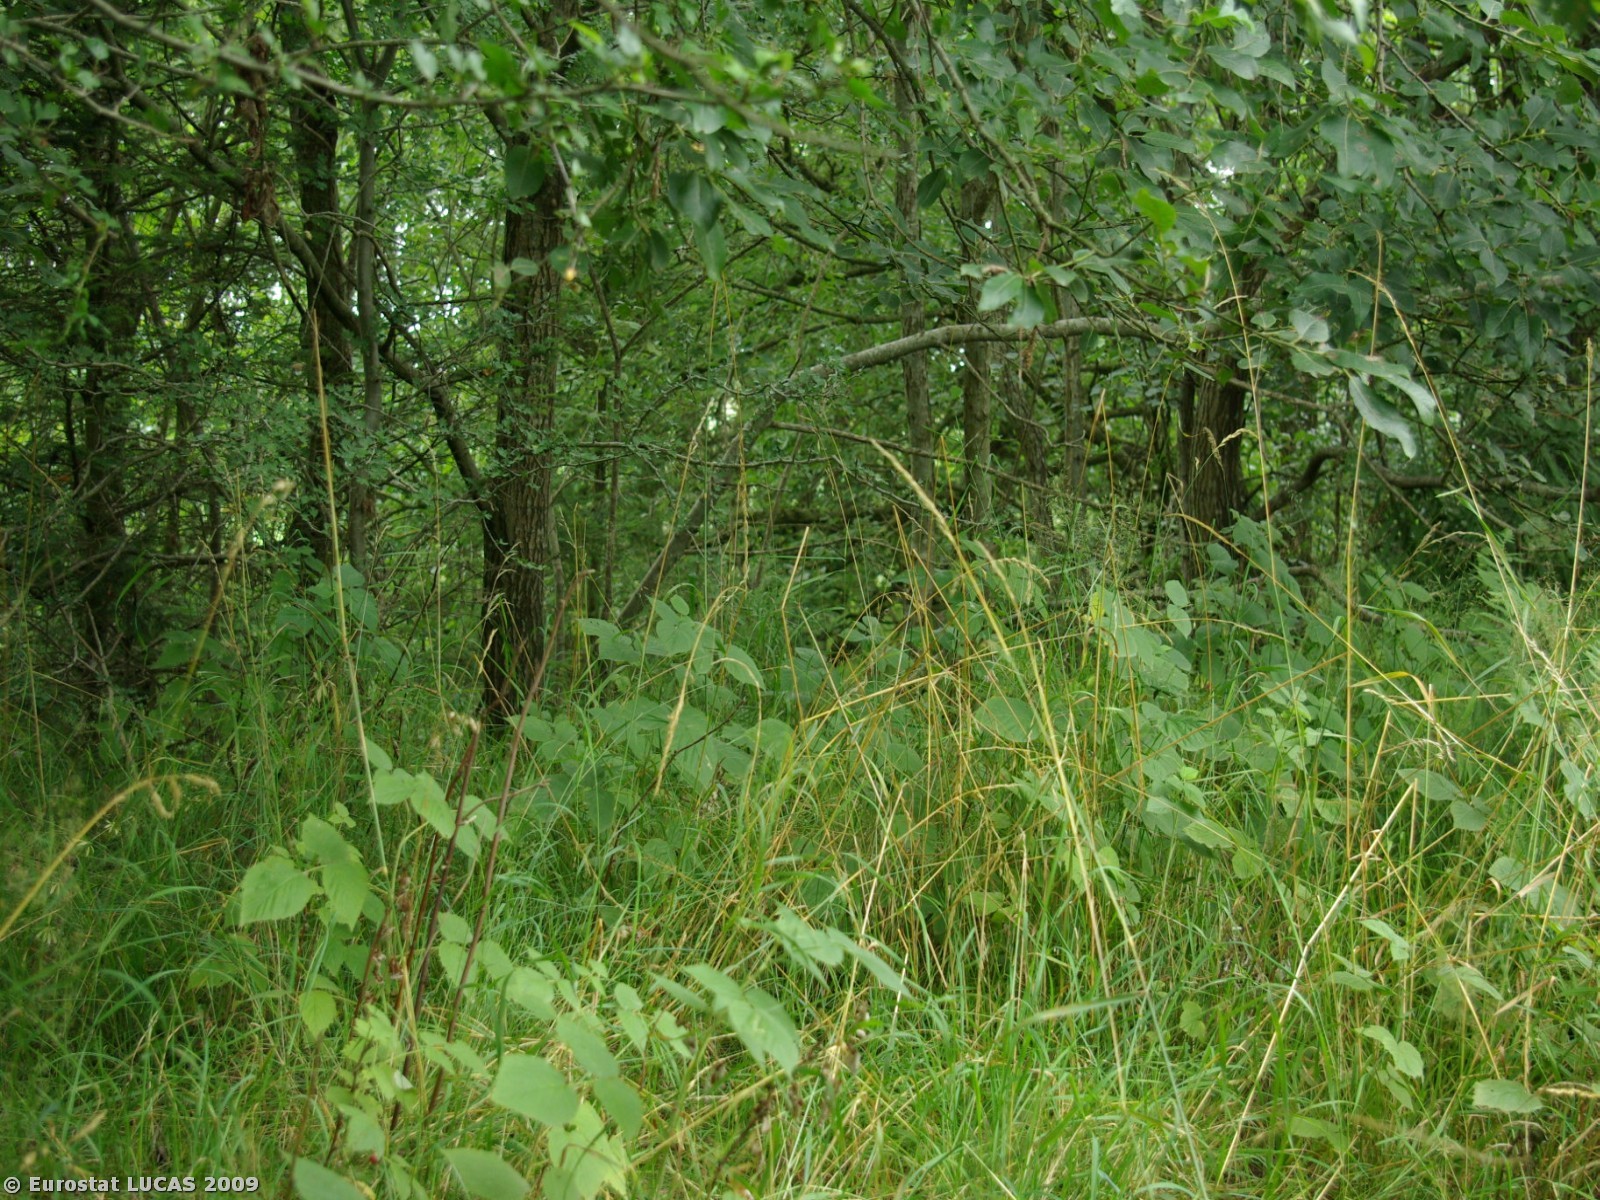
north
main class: Woodland
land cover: Broadleaved woodland
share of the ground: 50 - 75 %
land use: Unused
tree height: > 5 m
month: July
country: DK
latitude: 55.2331
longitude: 9.2930
